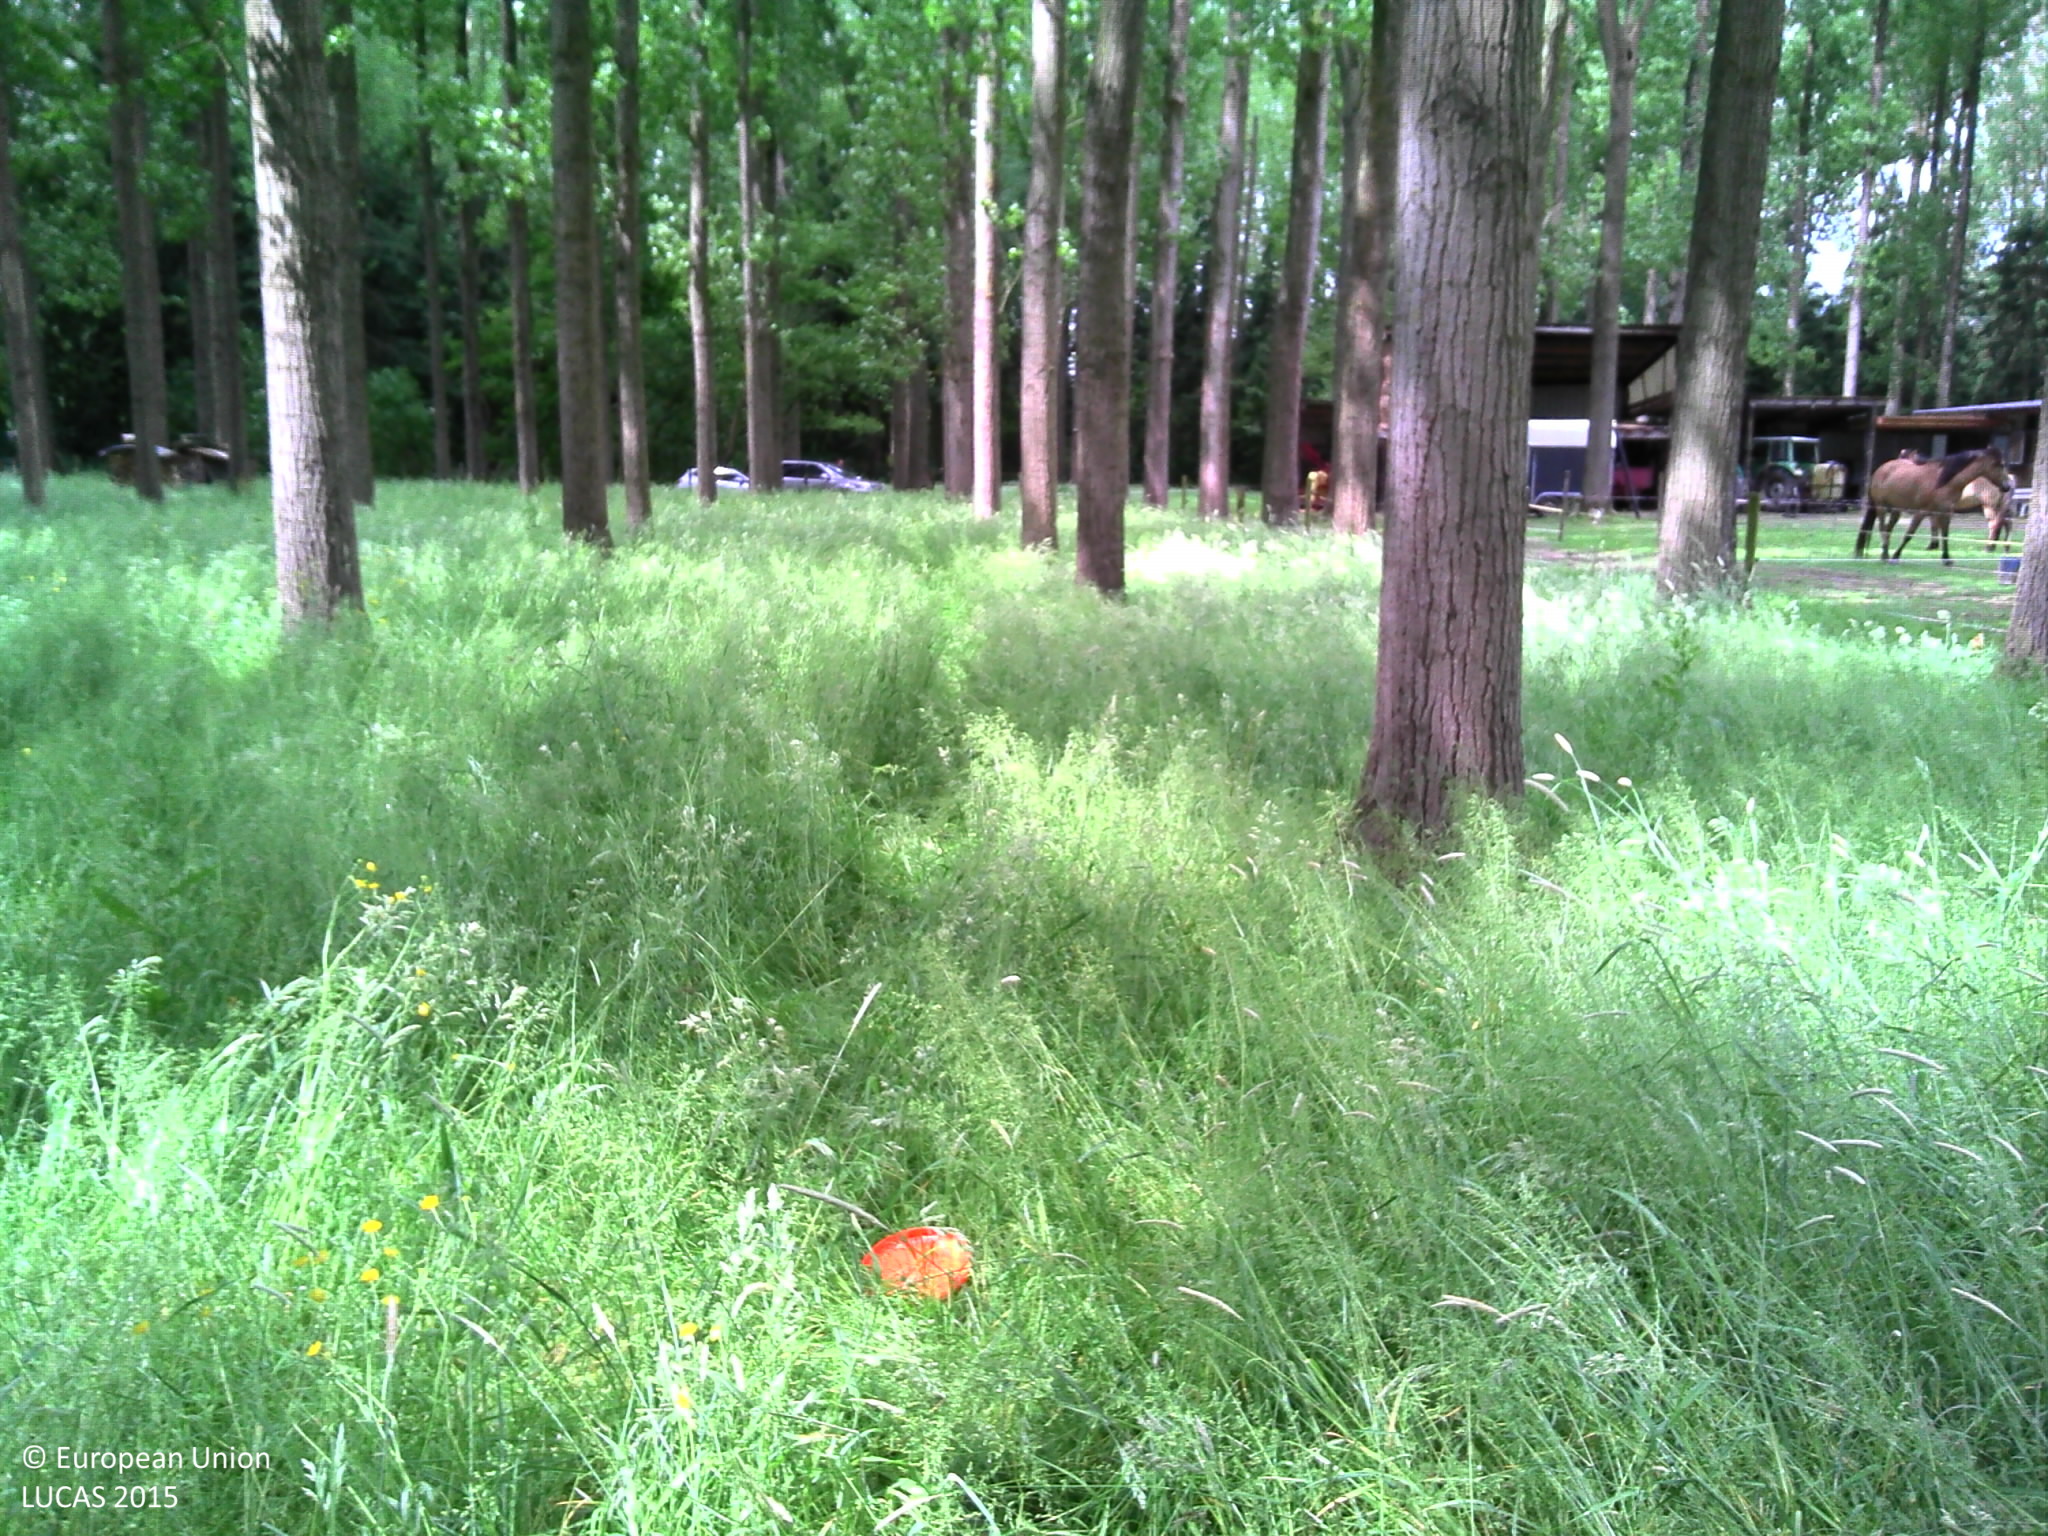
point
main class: Woodland
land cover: Broadleaved woodland
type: exotic forest
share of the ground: > 75 %
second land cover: Grassland without tree/shrub cover
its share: > 75 %
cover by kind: broadleaved forest trees 75 %, herbaceous plants 25 %
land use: Forestry
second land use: Agriculture (excluding fallow land and kitchen gardens)
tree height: > 5 m
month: June
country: BE
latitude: 50.9817
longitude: 3.9974
